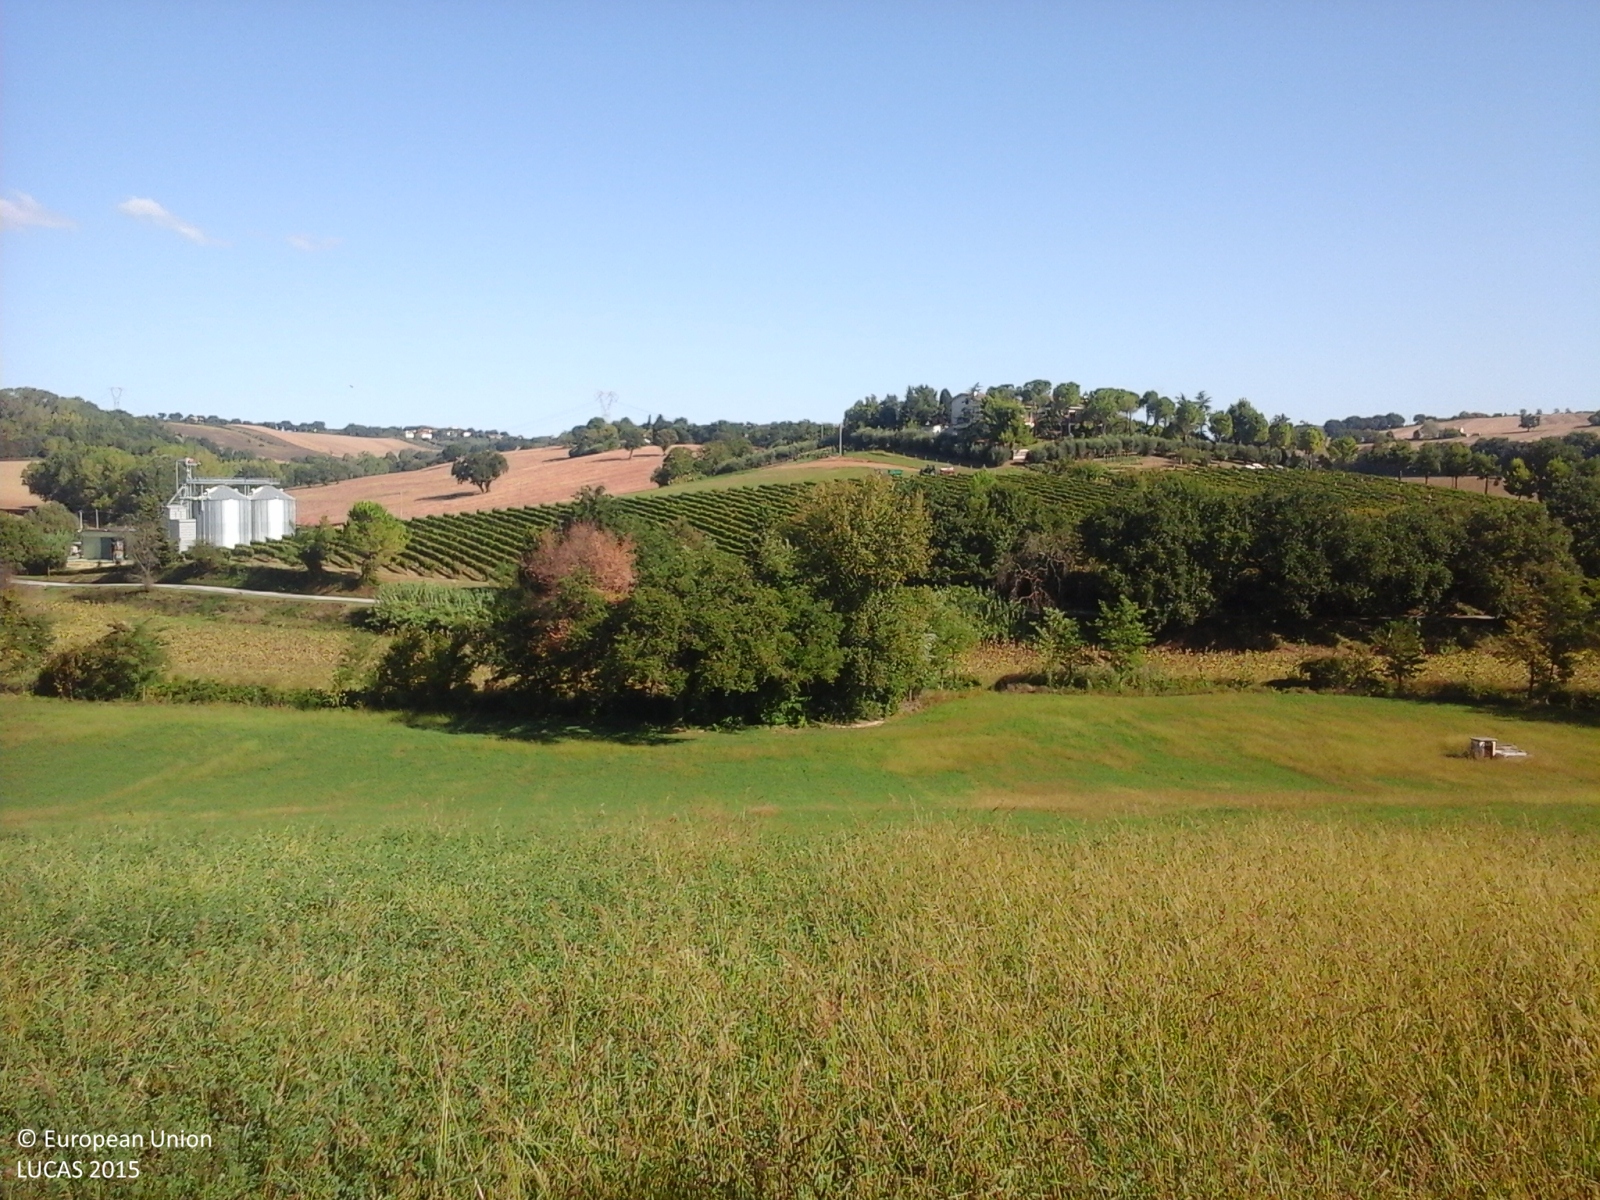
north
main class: Cropland
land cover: Lucerne
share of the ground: > 75 %
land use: Agriculture (excluding fallow land and kitchen gardens)
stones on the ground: < 10 %
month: September
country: IT
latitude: 43.6707
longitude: 13.1551
